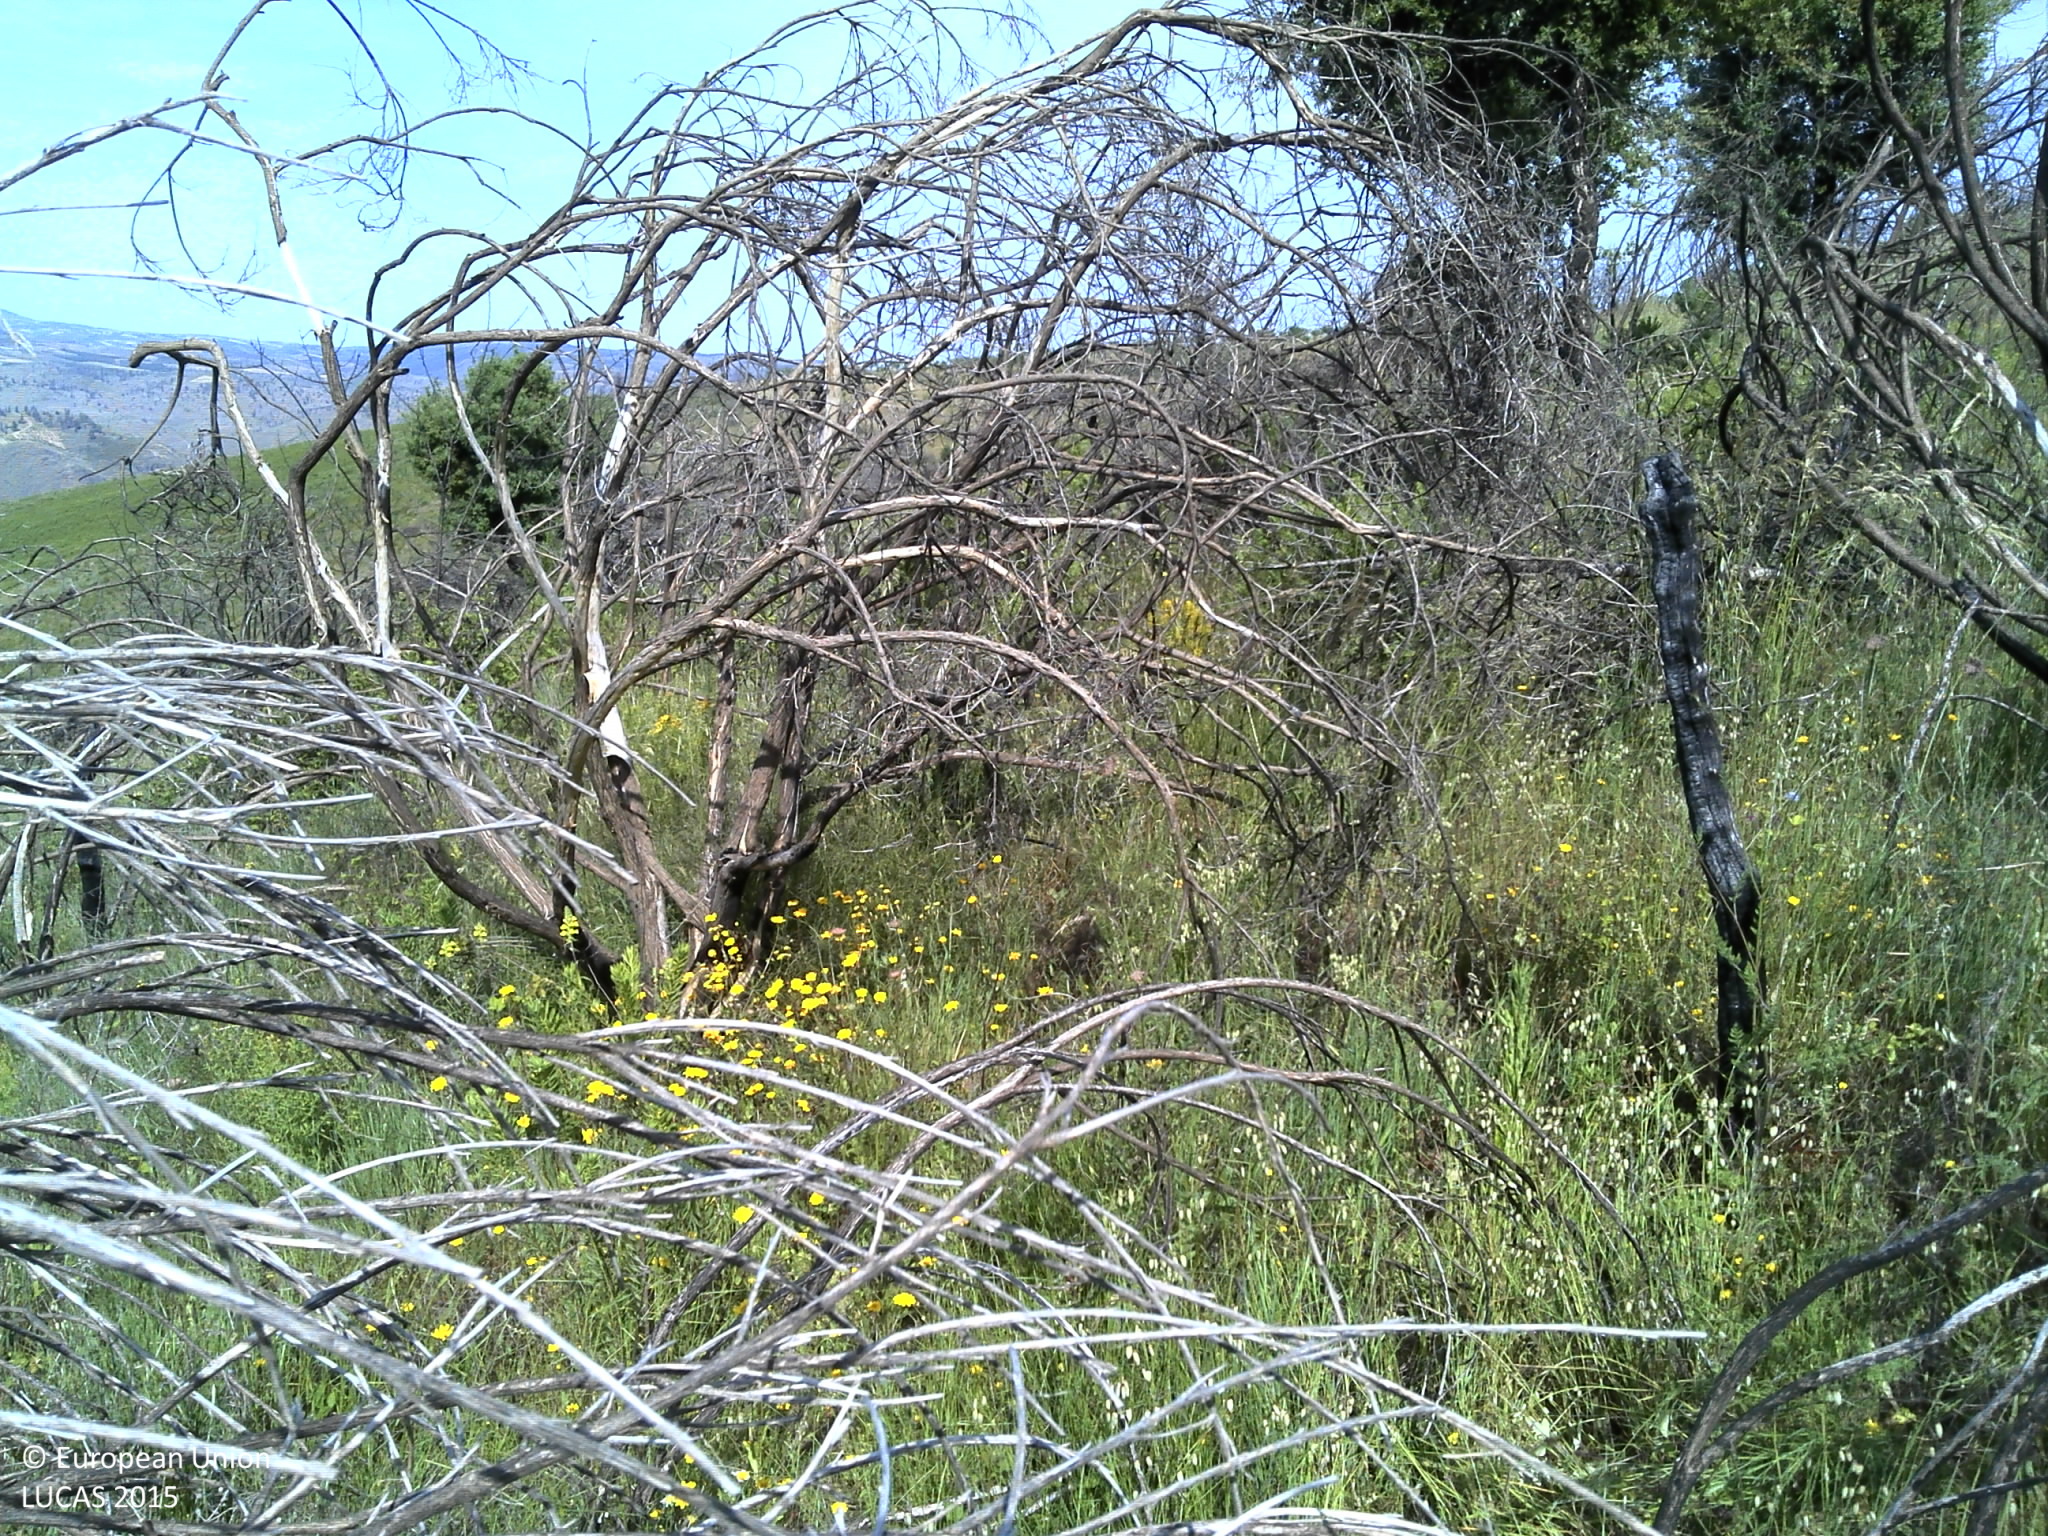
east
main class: Shrubland
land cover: Shrubland with sparse tree cover
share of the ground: 10 - 25 %
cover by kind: herbaceous plants 75 %, shrubs 20 %, broadleaved forest trees 5 %
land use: Abandoned areas
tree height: > 5 m
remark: Burnt area
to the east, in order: Shrubland with sparse tree cover; Shruby margins; Nuts trees
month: May
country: PT
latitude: 41.2272
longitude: -6.8682
